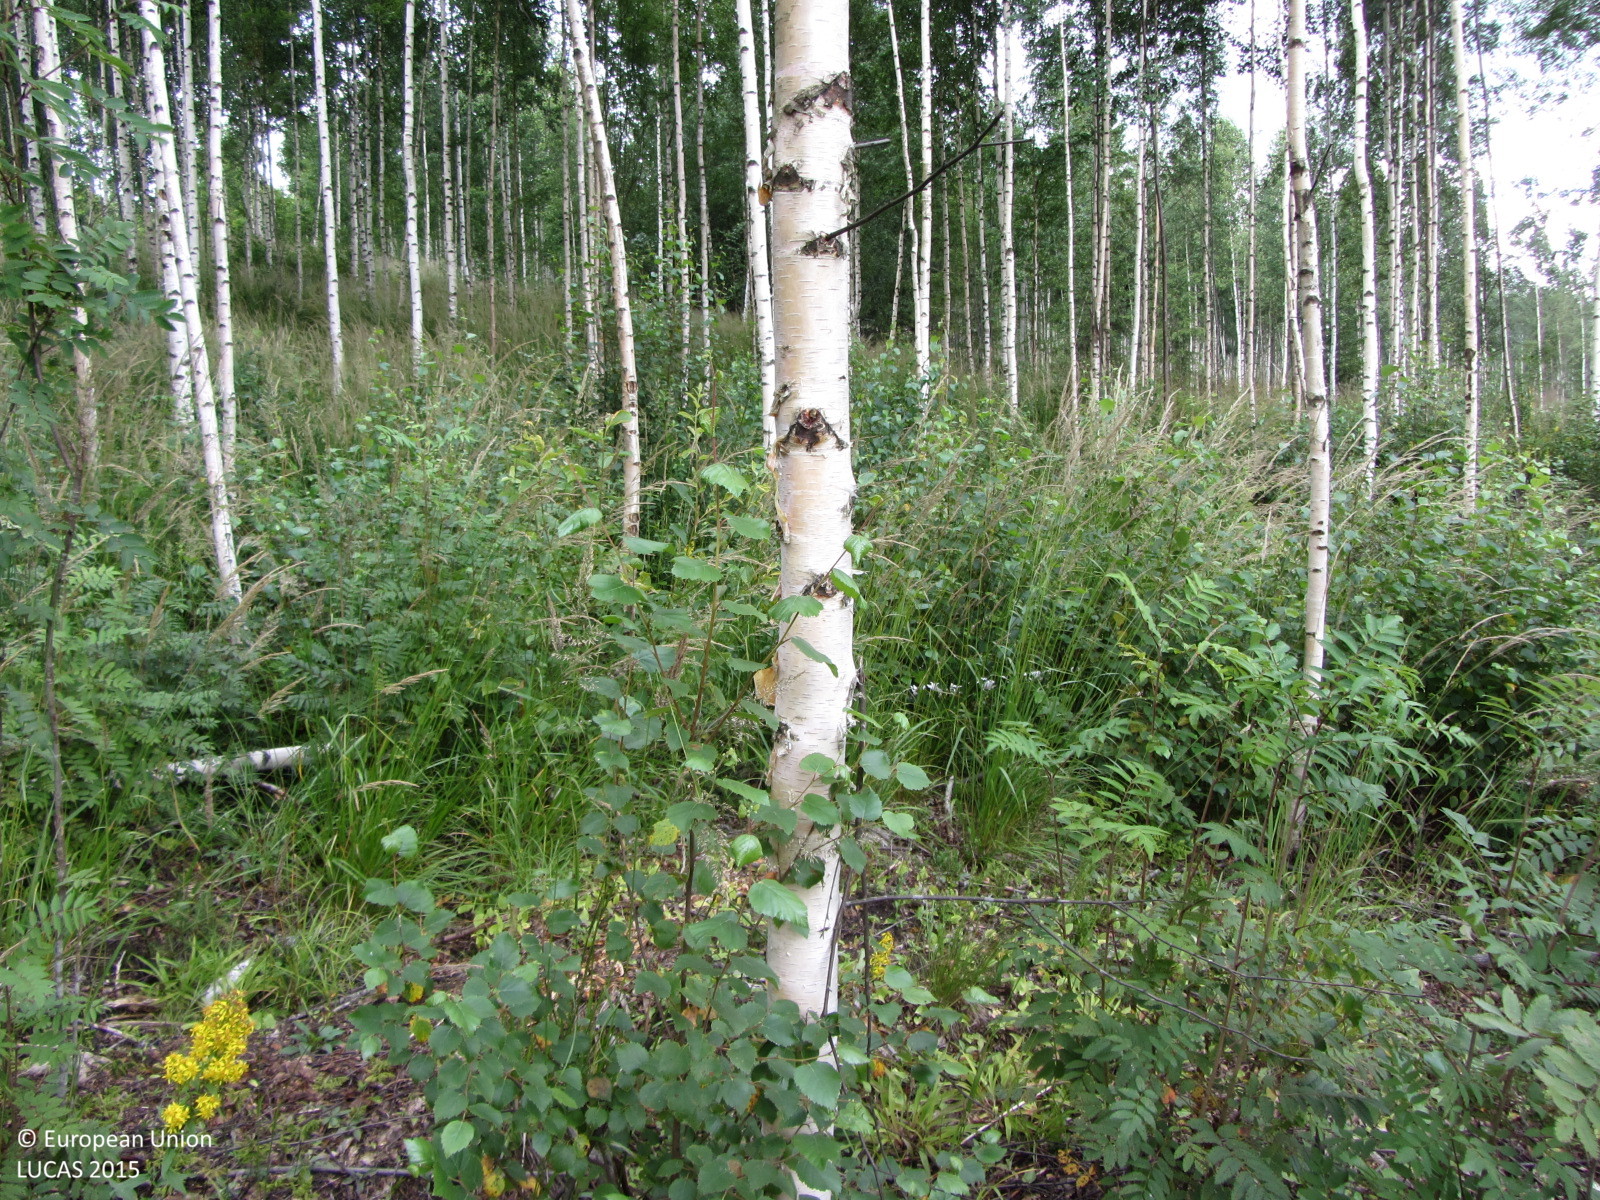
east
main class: Woodland
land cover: Broadleaved woodland
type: boreal forest
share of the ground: 25 - 50 %
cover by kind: herbaceous plants 55 %, broadleaved forest trees 45 %
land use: Forestry
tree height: > 5 m
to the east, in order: Broadleaved woodland; Grassland with sparse tree/shrub cover; Broadleaved woodland; Other mixed woodland; Pine dominated coniferous woodland
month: July
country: FI
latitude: 60.5368
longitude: 24.9335
